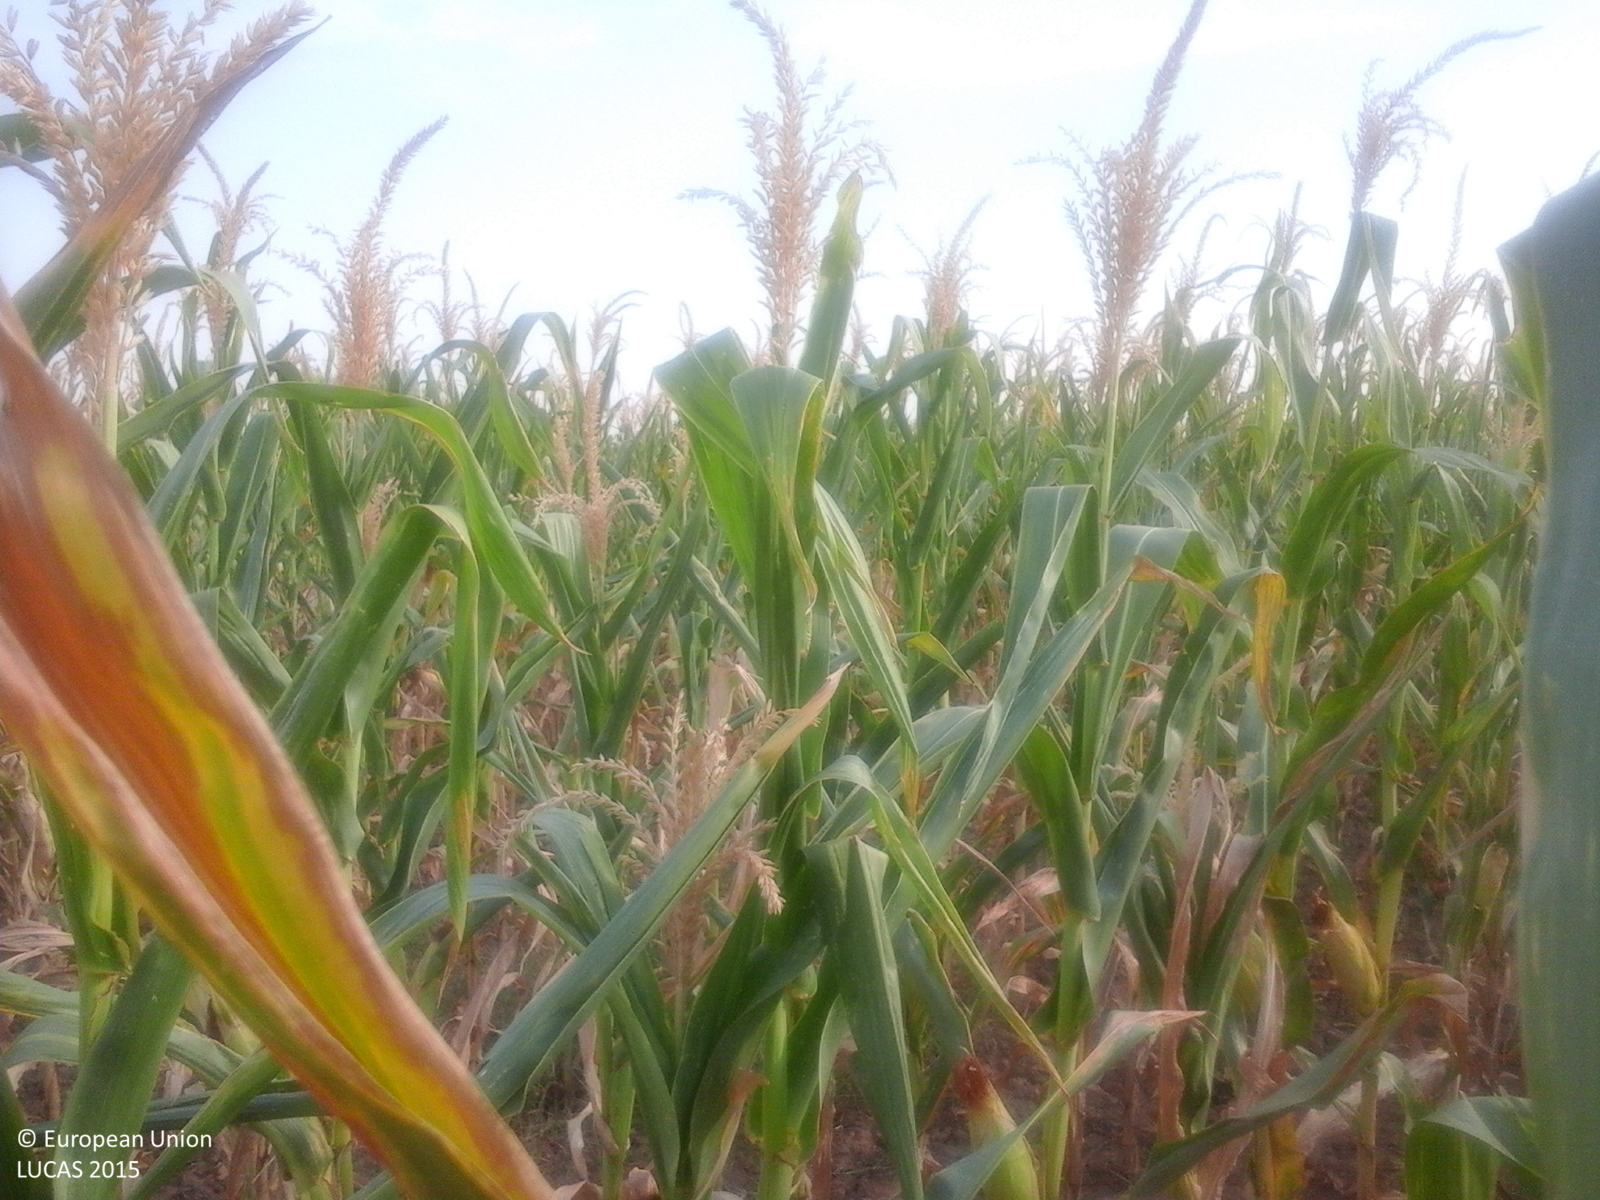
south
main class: Cropland
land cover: Maize
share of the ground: > 75 %
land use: Agriculture (excluding fallow land and kitchen gardens)
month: August
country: RO
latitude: 44.2417
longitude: 22.6987
